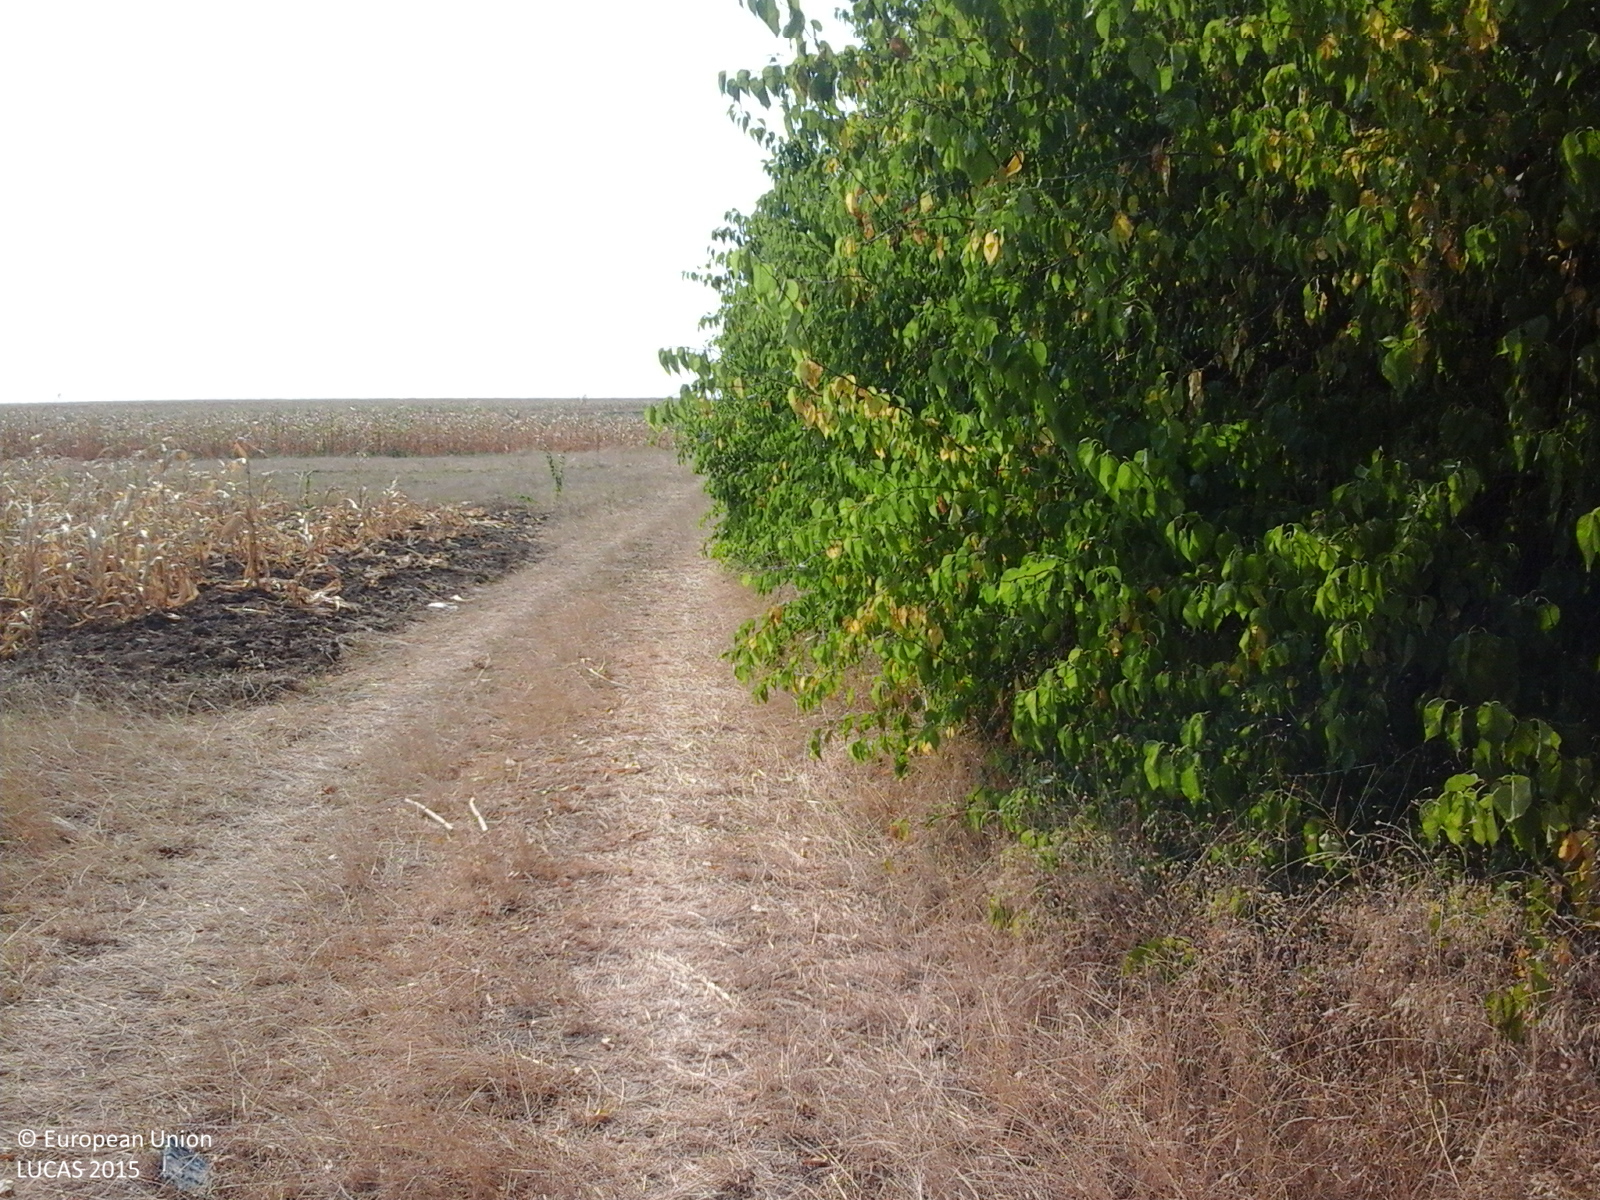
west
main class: Shrubland
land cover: Shrubland with sparse tree cover
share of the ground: > 75 %
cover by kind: shrubs 95 %, broadleaved forest trees 5 %
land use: Semi-natural and natural areas not in use
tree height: > 5 m
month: August
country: RO
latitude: 44.3680
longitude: 23.5683
